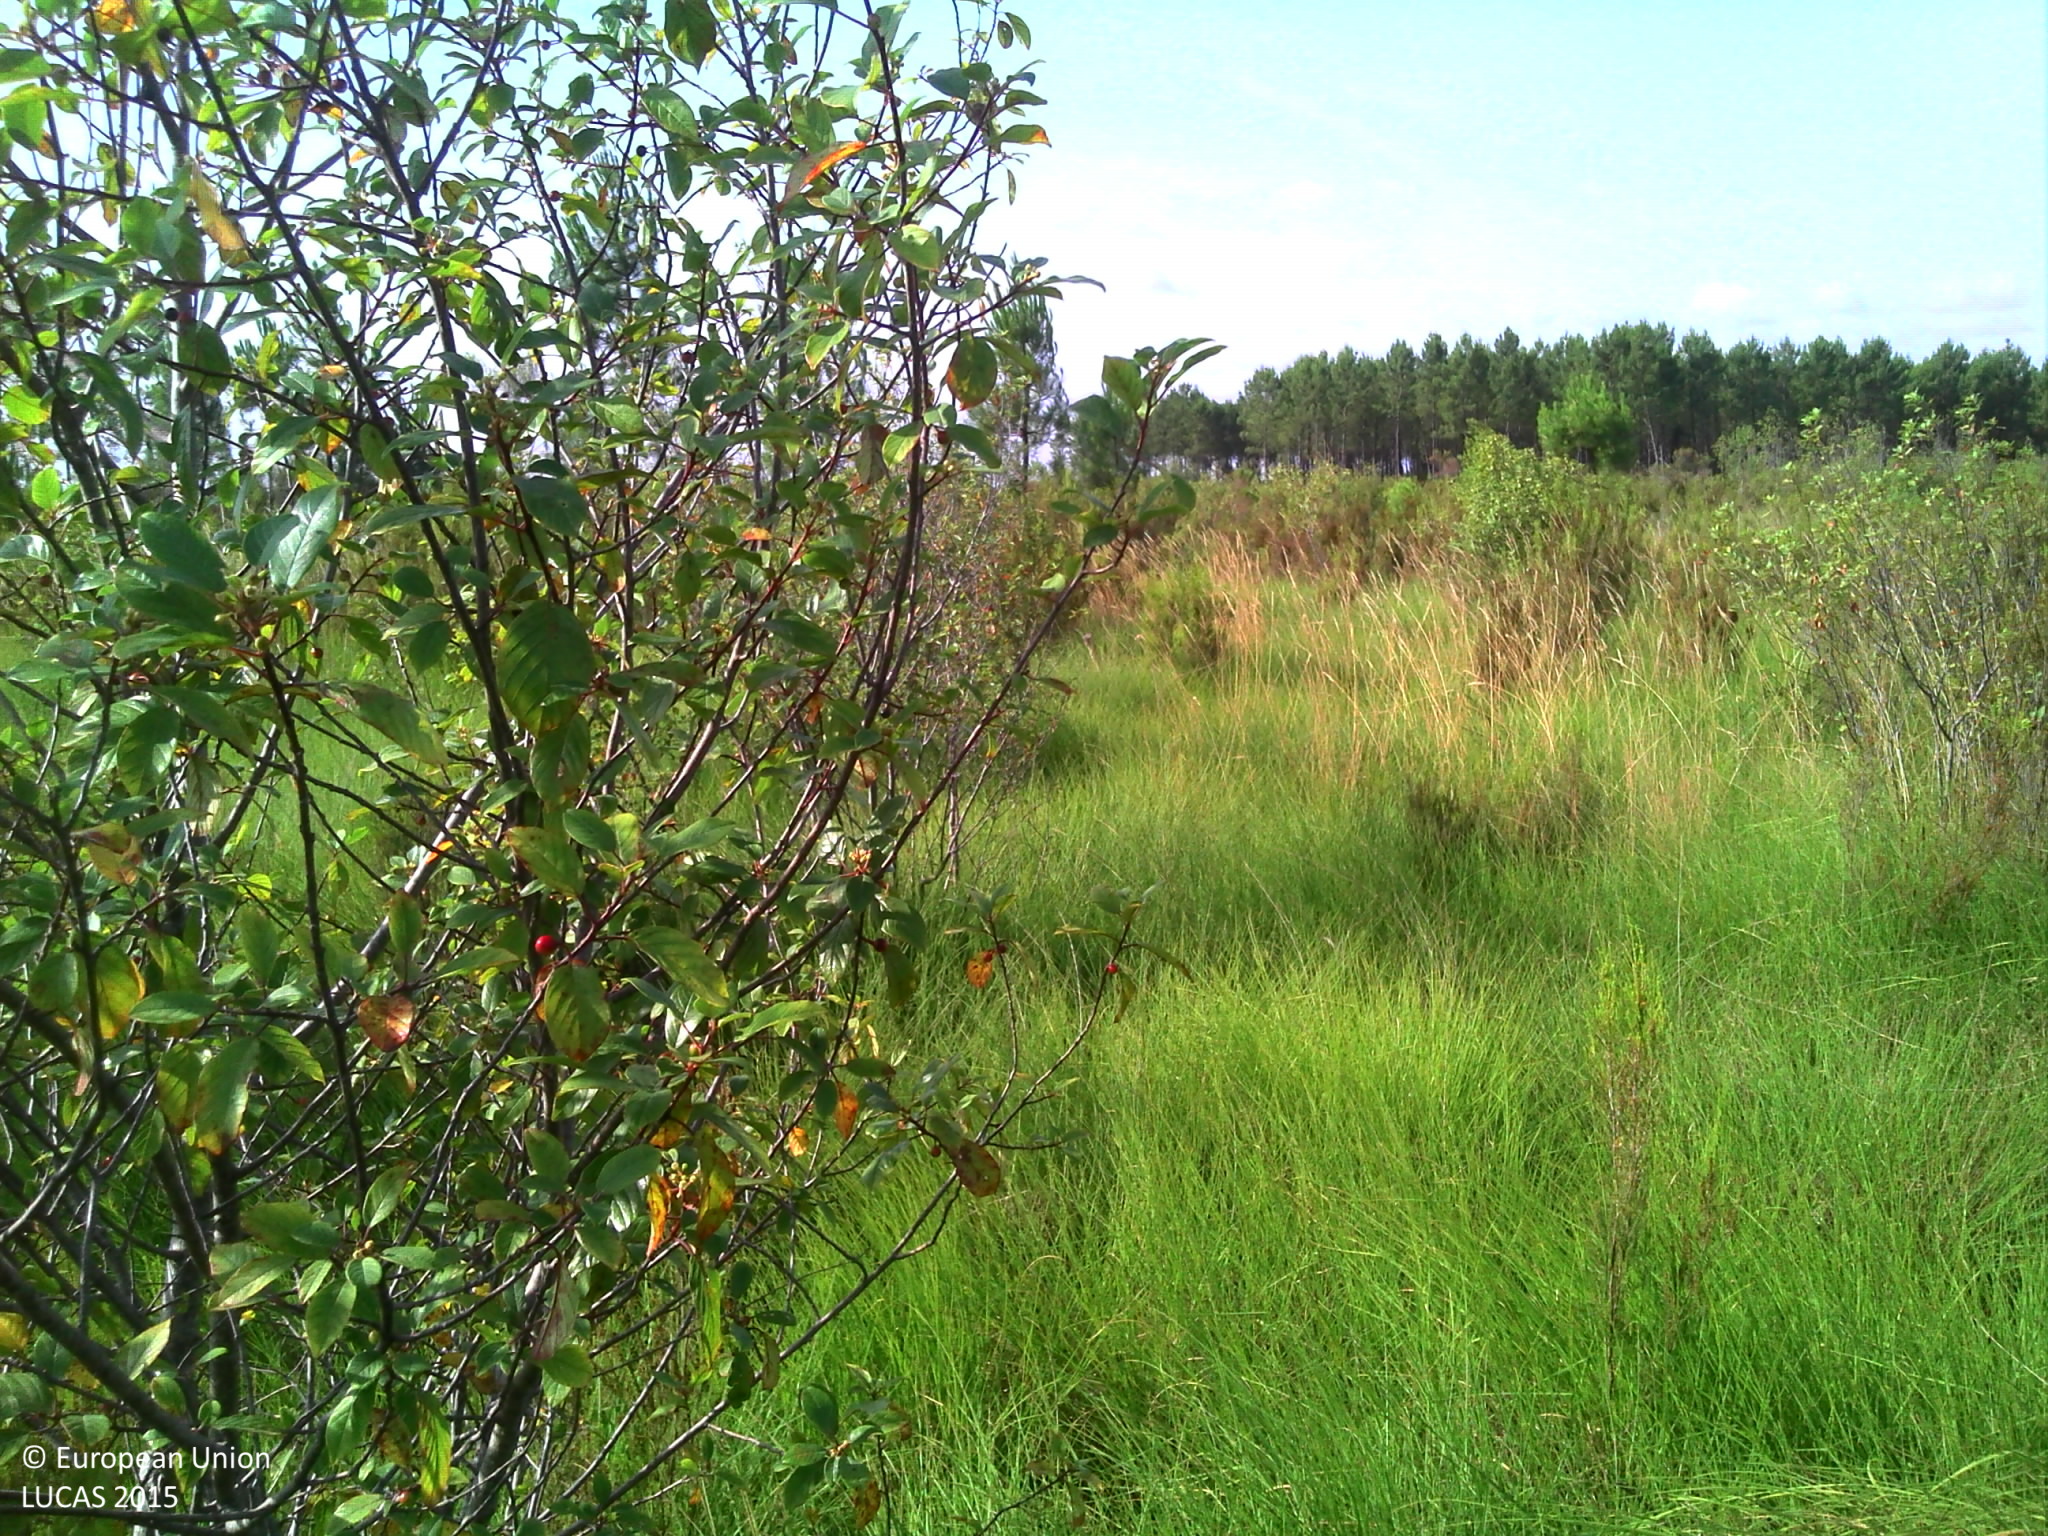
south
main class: Shrubland
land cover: Shrubland with sparse tree cover
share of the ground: > 75 %
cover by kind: shrubs 70 %, herbaceous plants 25 %, coniferous forest trees 5 %
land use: Forestry
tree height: < 5 m
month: July
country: FR
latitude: 44.1129
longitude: -0.6223
